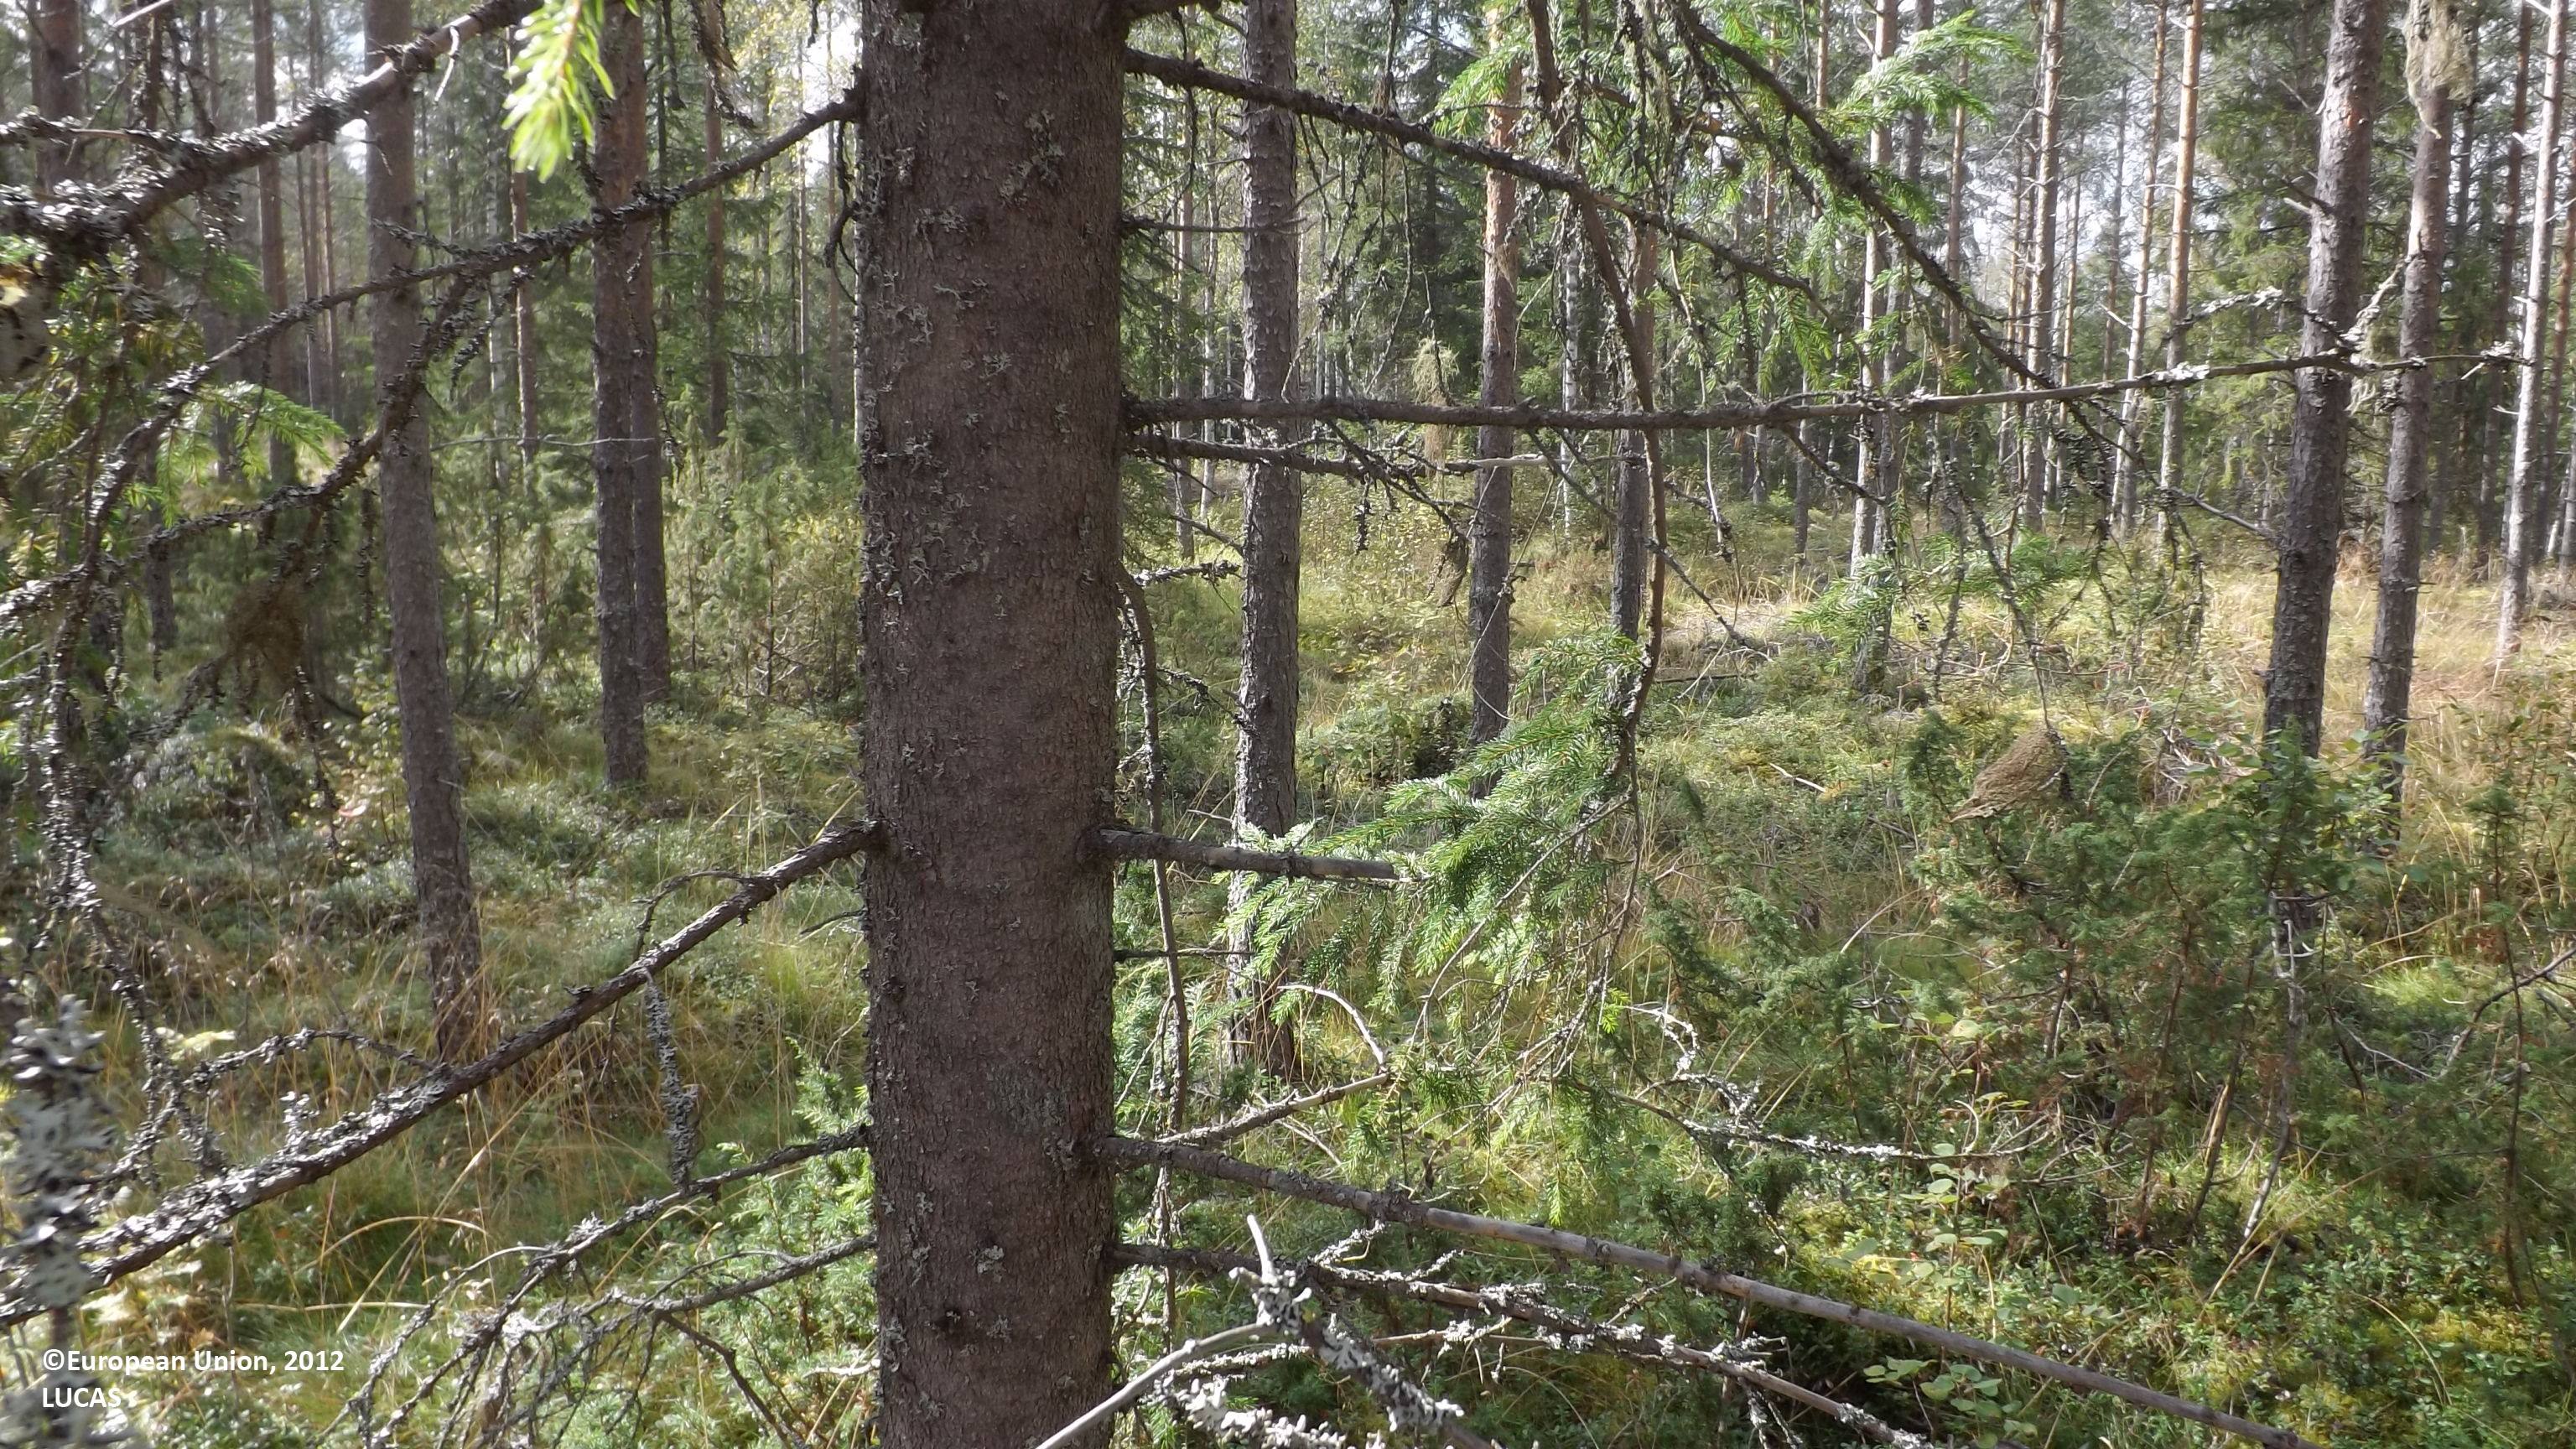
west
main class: Woodland
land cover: Pine dominated mixed woodland
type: boreal forest
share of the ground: 50 - 75 %
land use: Forestry
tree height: > 5 m
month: August
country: FI
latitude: 63.7099
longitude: 23.4762
